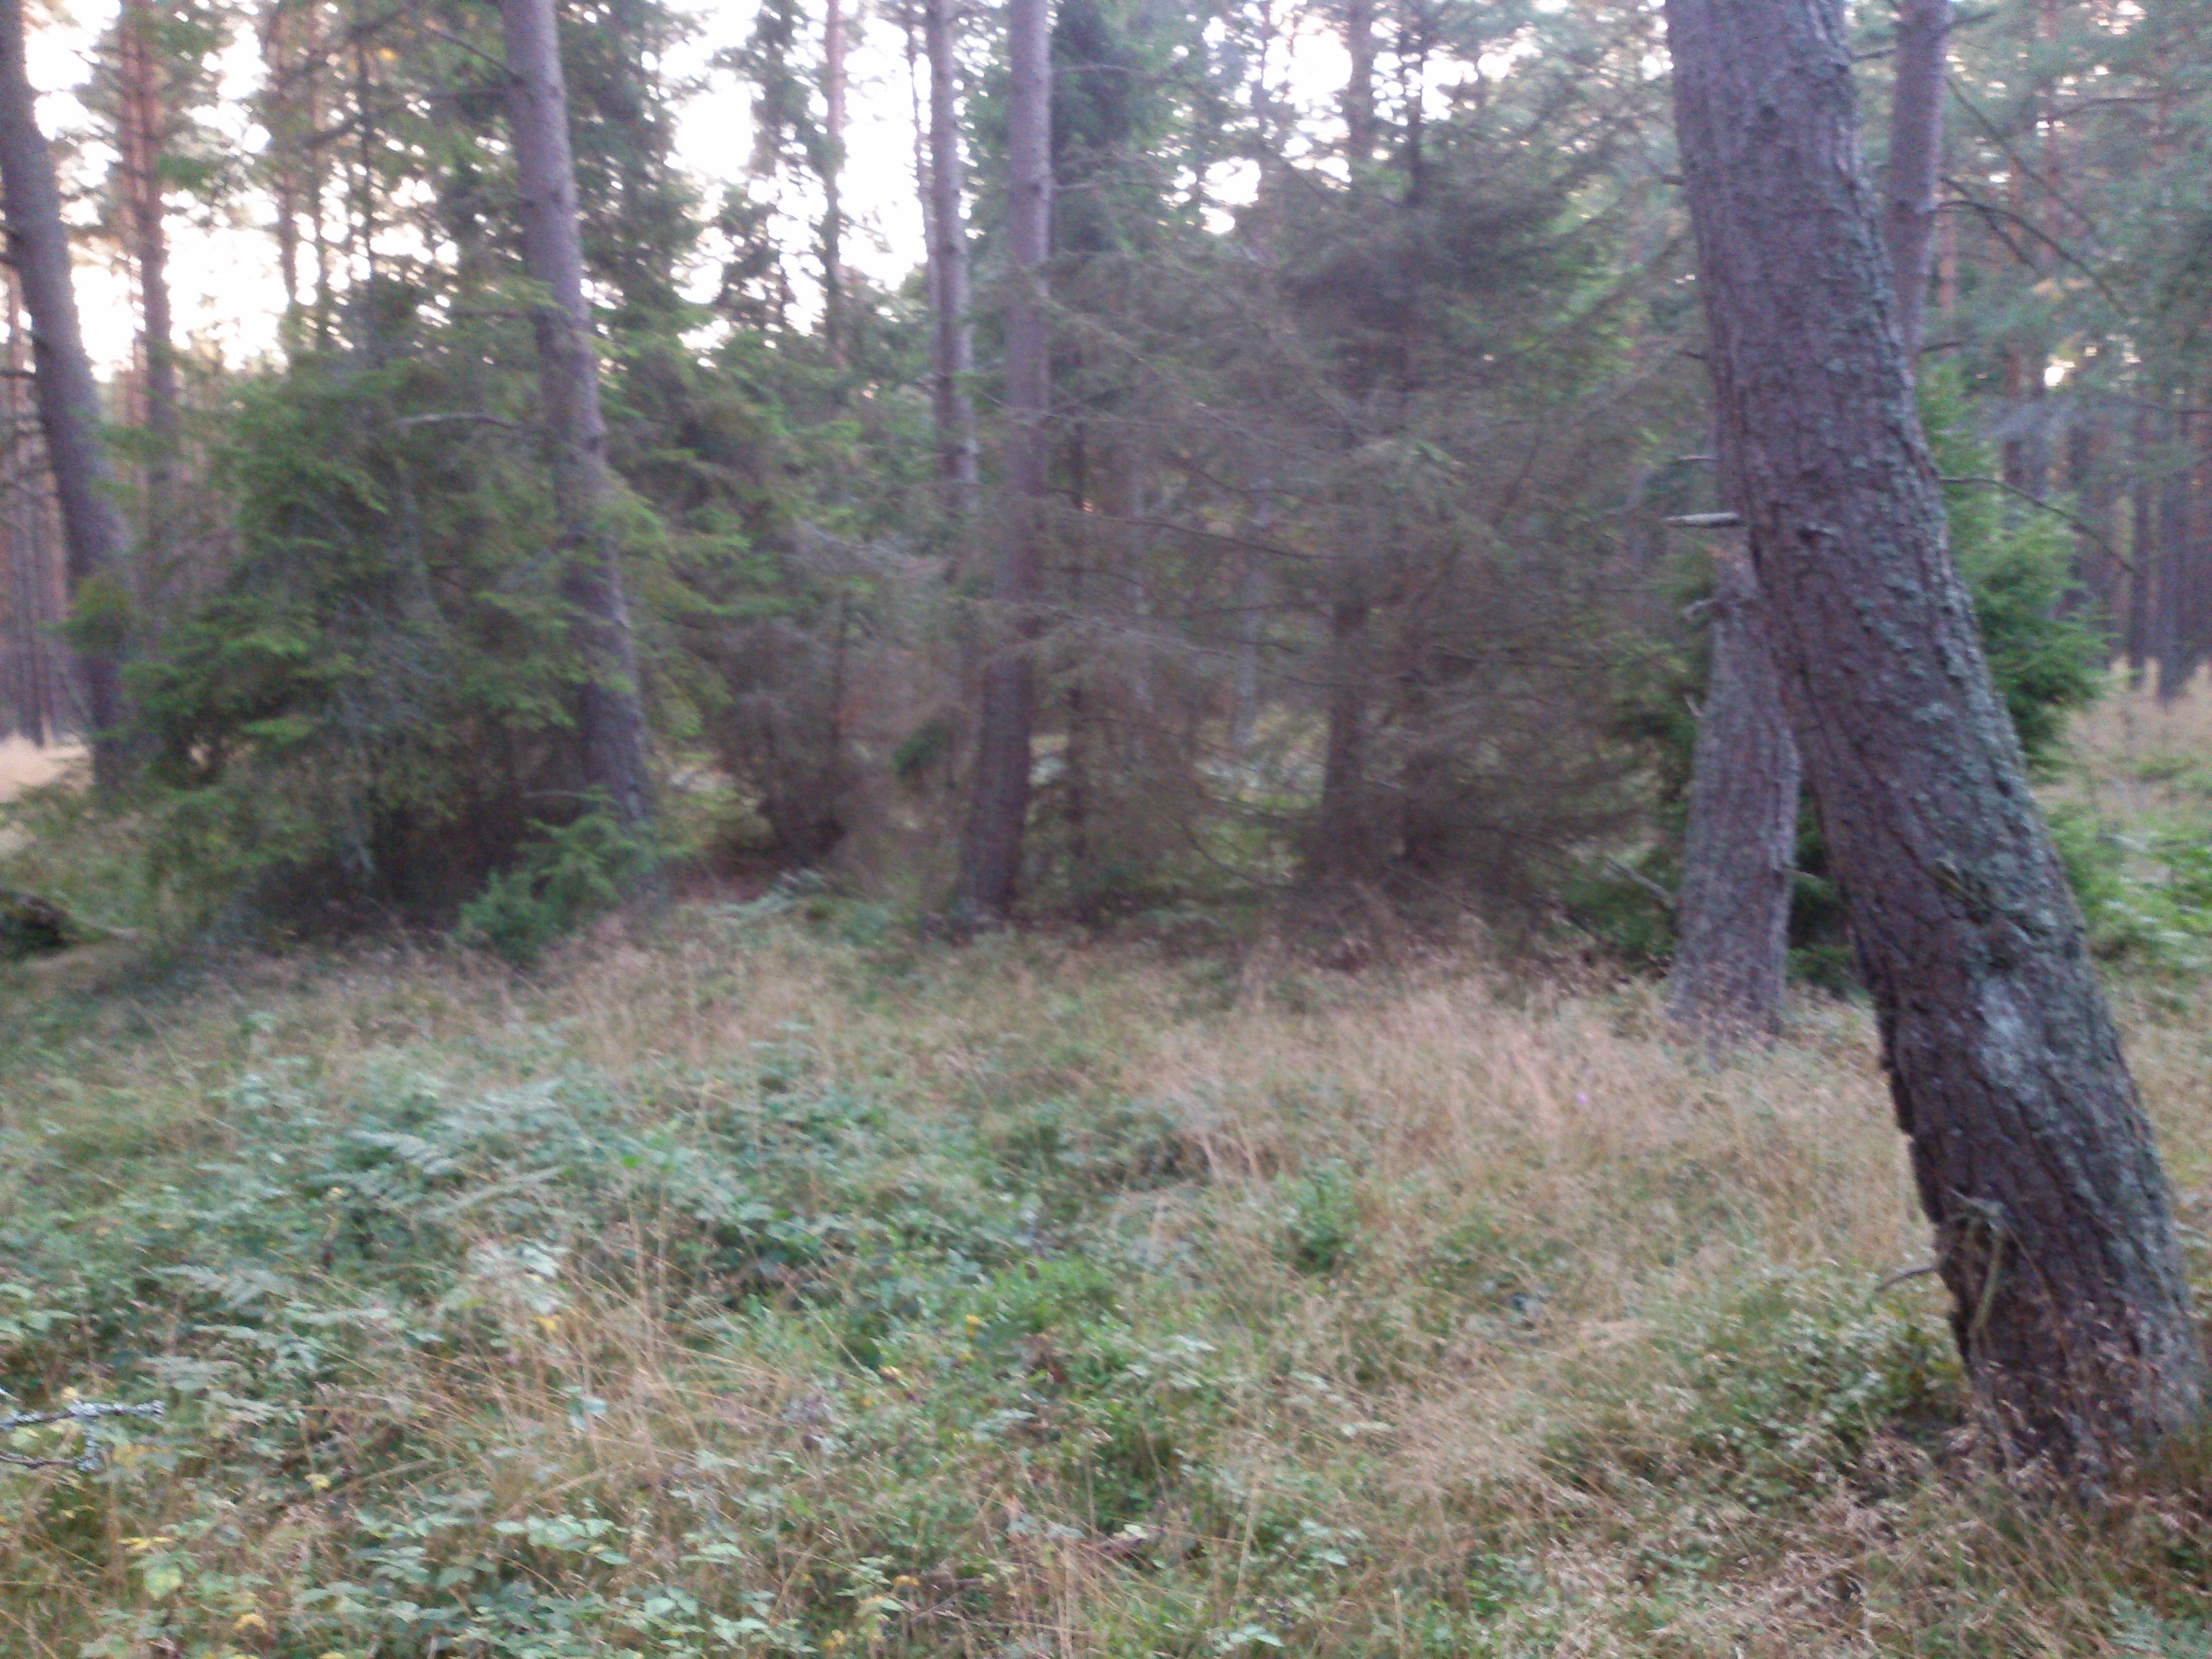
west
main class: Woodland
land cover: Pine dominated coniferous woodland
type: hemiboreal forest and nemoral coniferous forest and mixed broadleaved-coniferous forest
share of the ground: 50 - 75 %
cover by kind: coniferous forest trees 65 %, herbaceous plants 25 %, shrubs 5 %, lichens and mosses 5 %
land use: Forestry
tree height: > 5 m
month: August
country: PL
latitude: 53.8035
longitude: 17.1613
